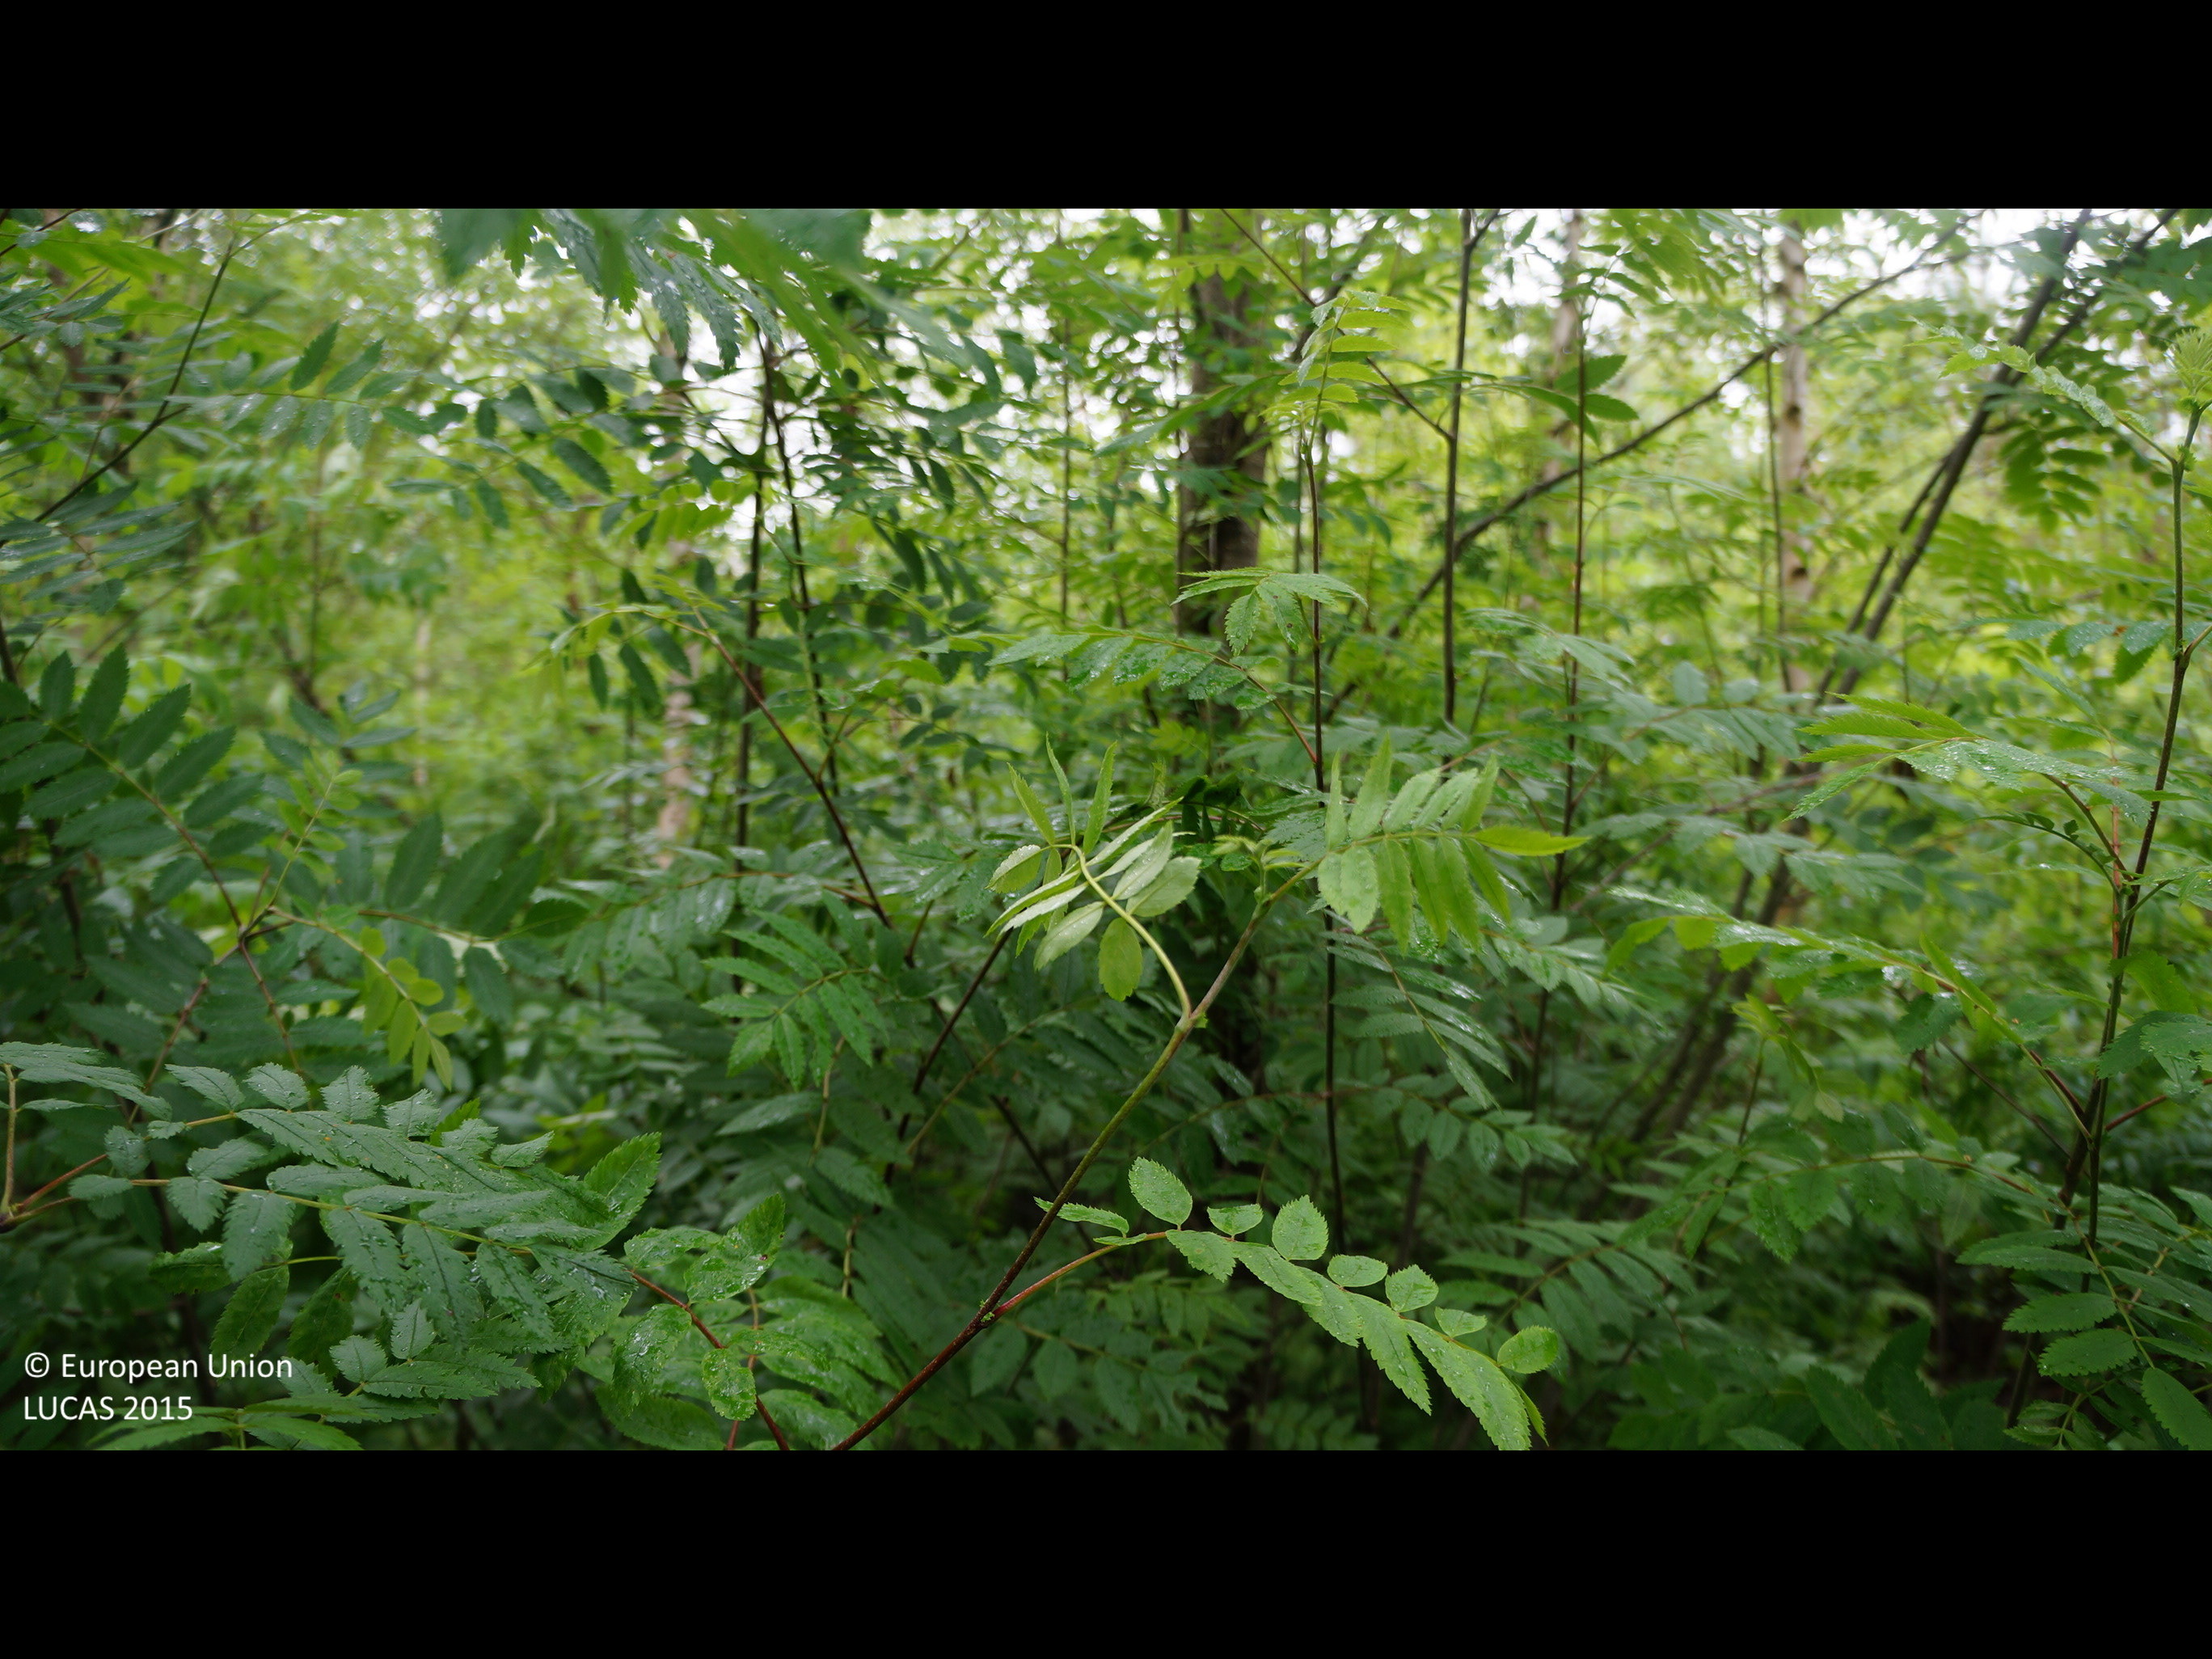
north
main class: Woodland
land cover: Broadleaved woodland
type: non-riverine alder, birch or aspen forest
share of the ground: > 75 %
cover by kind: broadleaved forest trees 90 %, shrubs 10 %
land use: Forestry
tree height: > 5 m
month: June
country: FI
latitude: 64.6300
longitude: 25.2911
